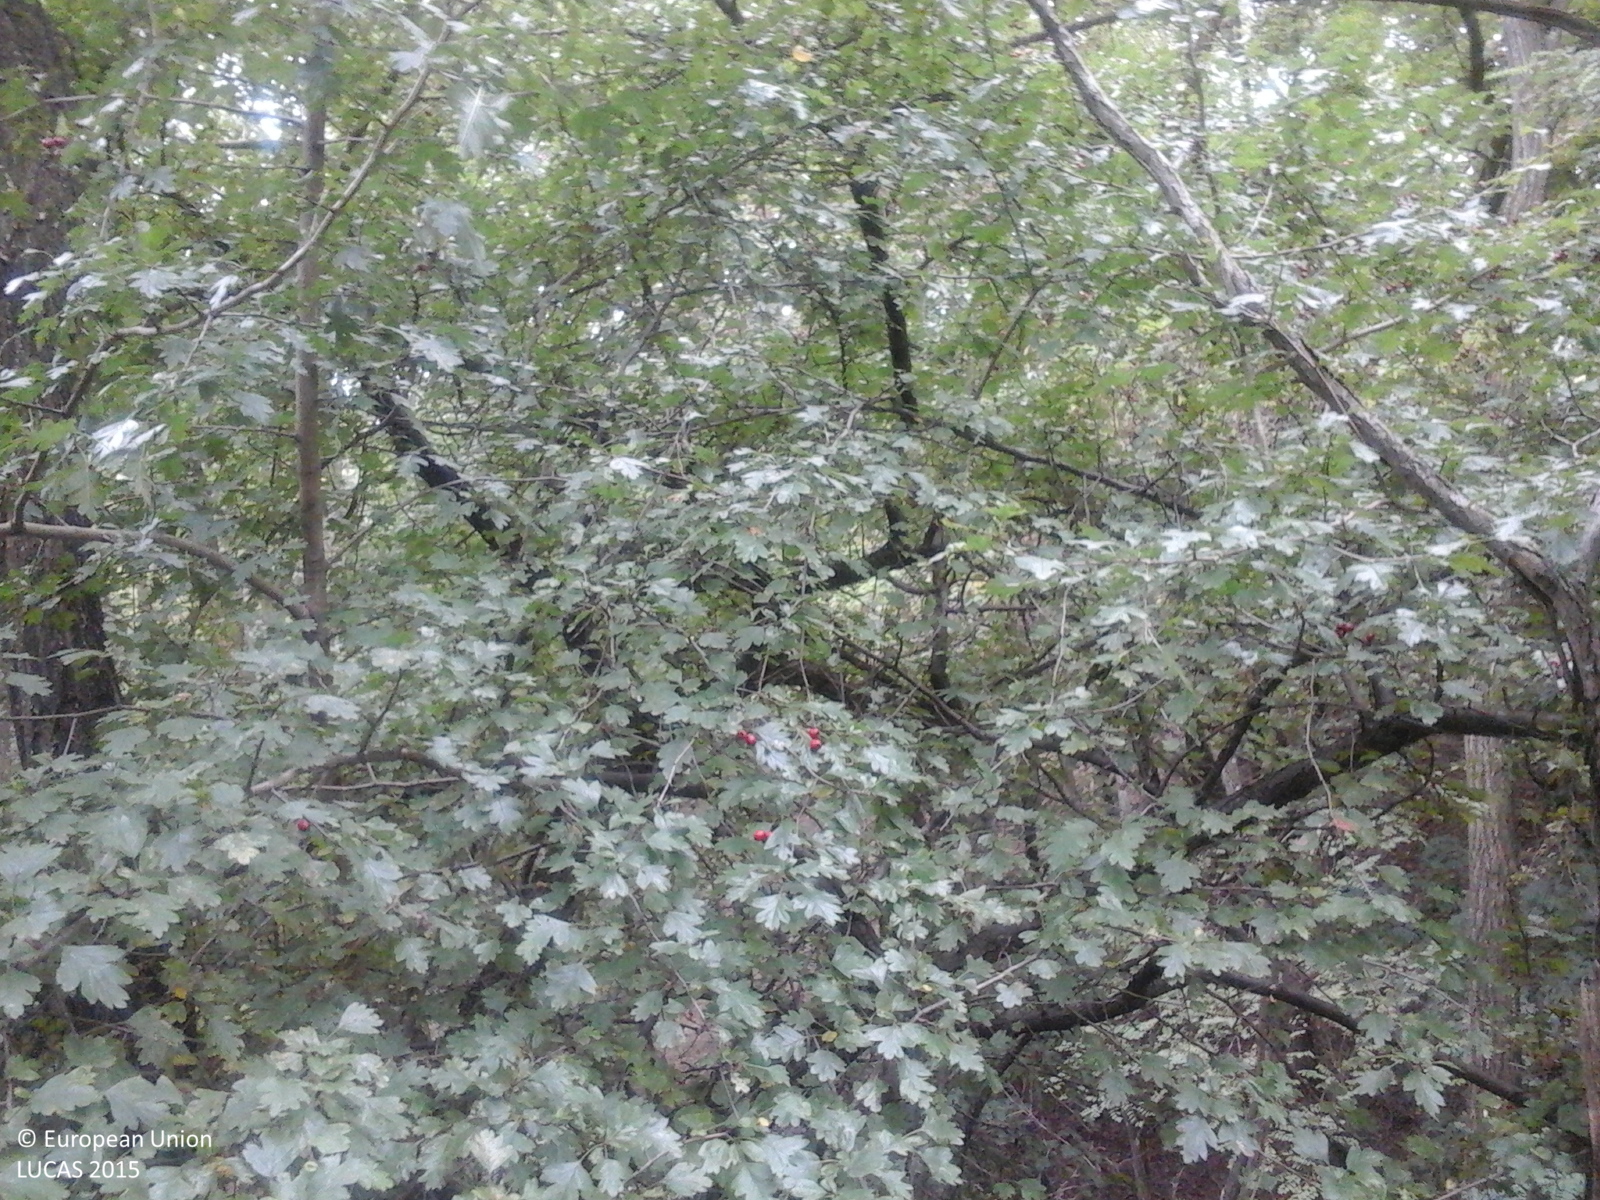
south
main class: Woodland
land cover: Broadleaved woodland
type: exotic forest
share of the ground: > 75 %
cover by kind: broadleaved forest trees 100 %
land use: Forestry
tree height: > 5 m
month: October
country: RO
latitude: 46.0460
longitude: 23.4392
